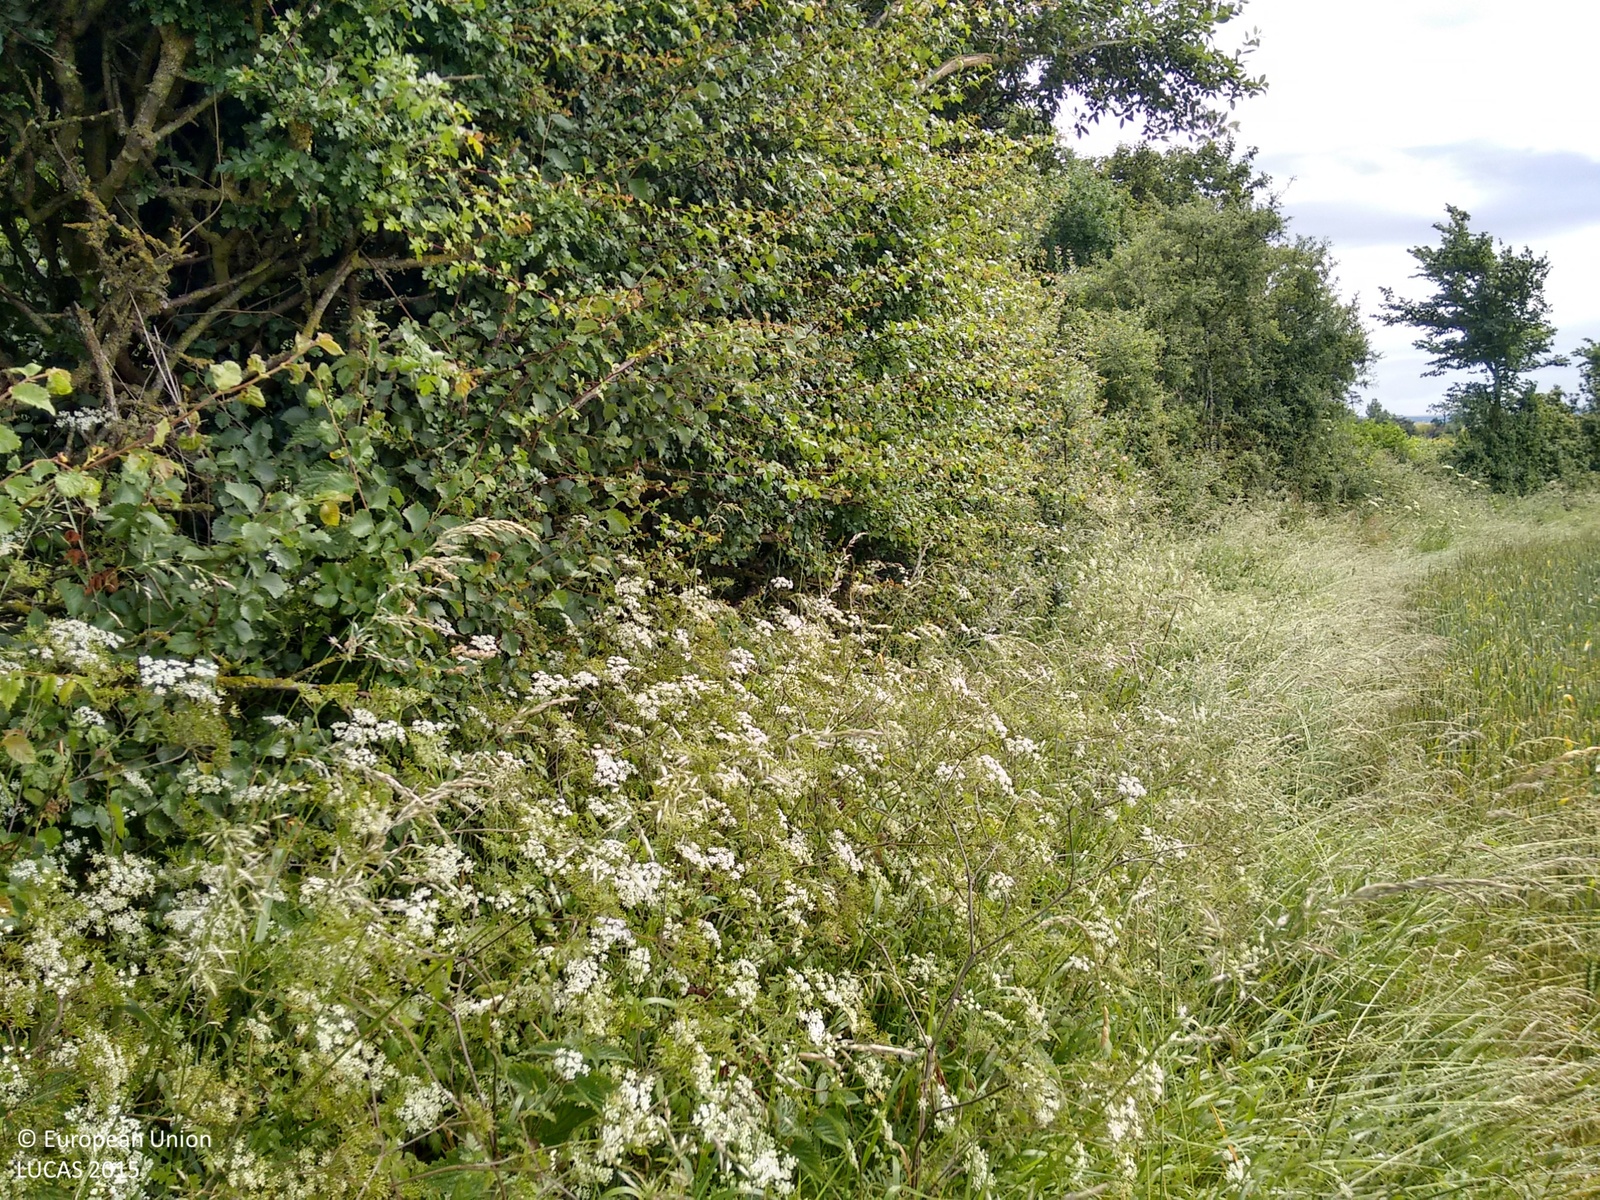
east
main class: Cropland
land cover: Common wheat
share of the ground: > 75 %
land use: Agriculture (excluding fallow land and kitchen gardens)
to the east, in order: Common wheat; Grass margins; Lines of trees; Managed hedges; Paved roads, cycling and walking lanes; Managed hedges; Grass margins; Maize
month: June
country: GB
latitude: 51.2985
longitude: -2.2970
